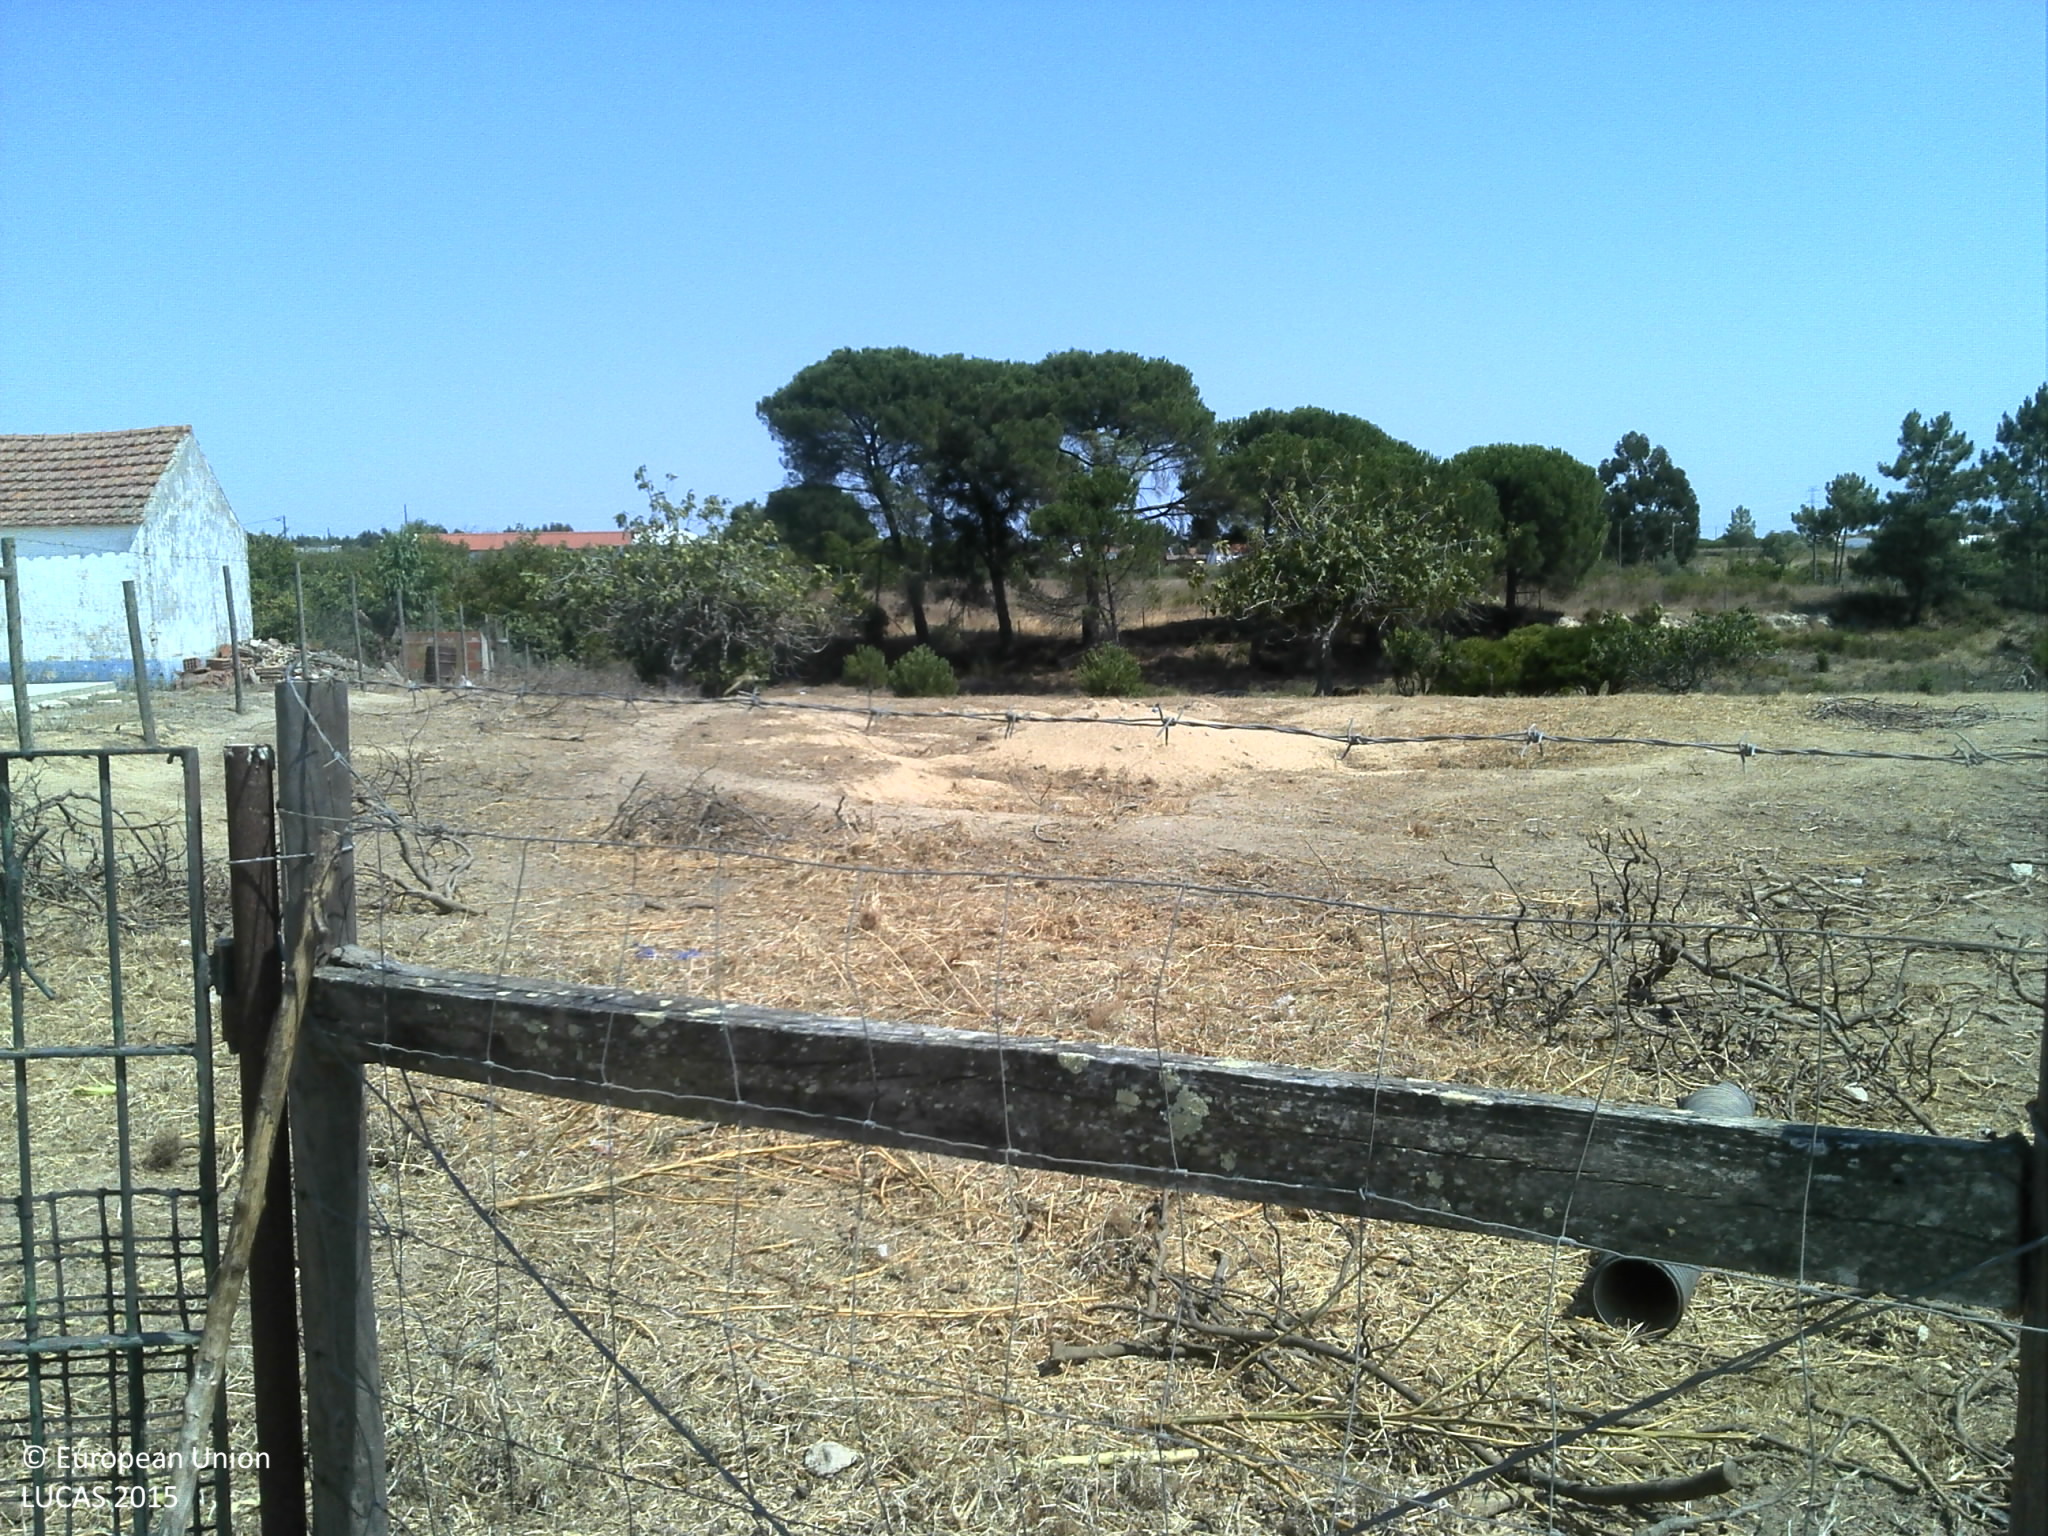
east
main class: Cropland
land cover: Other fruit trees and berries
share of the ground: 25 - 50 %
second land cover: Grassland without tree/shrub cover
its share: 25 - 50 %
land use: Agriculture (excluding fallow land and kitchen gardens)
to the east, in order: Other fruit trees and berries; Grassland without tree/shrub cover; Single bushes/trees; Fences; Grassland without tree/shrub cover; Single bushes/trees; Pine dominated coniferous woodland; Grassland without tree/shrub cover; Permanent crops (only in case pi); Artificial constructions in urban areas
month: August
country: PT
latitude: 38.6790
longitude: -8.5770
